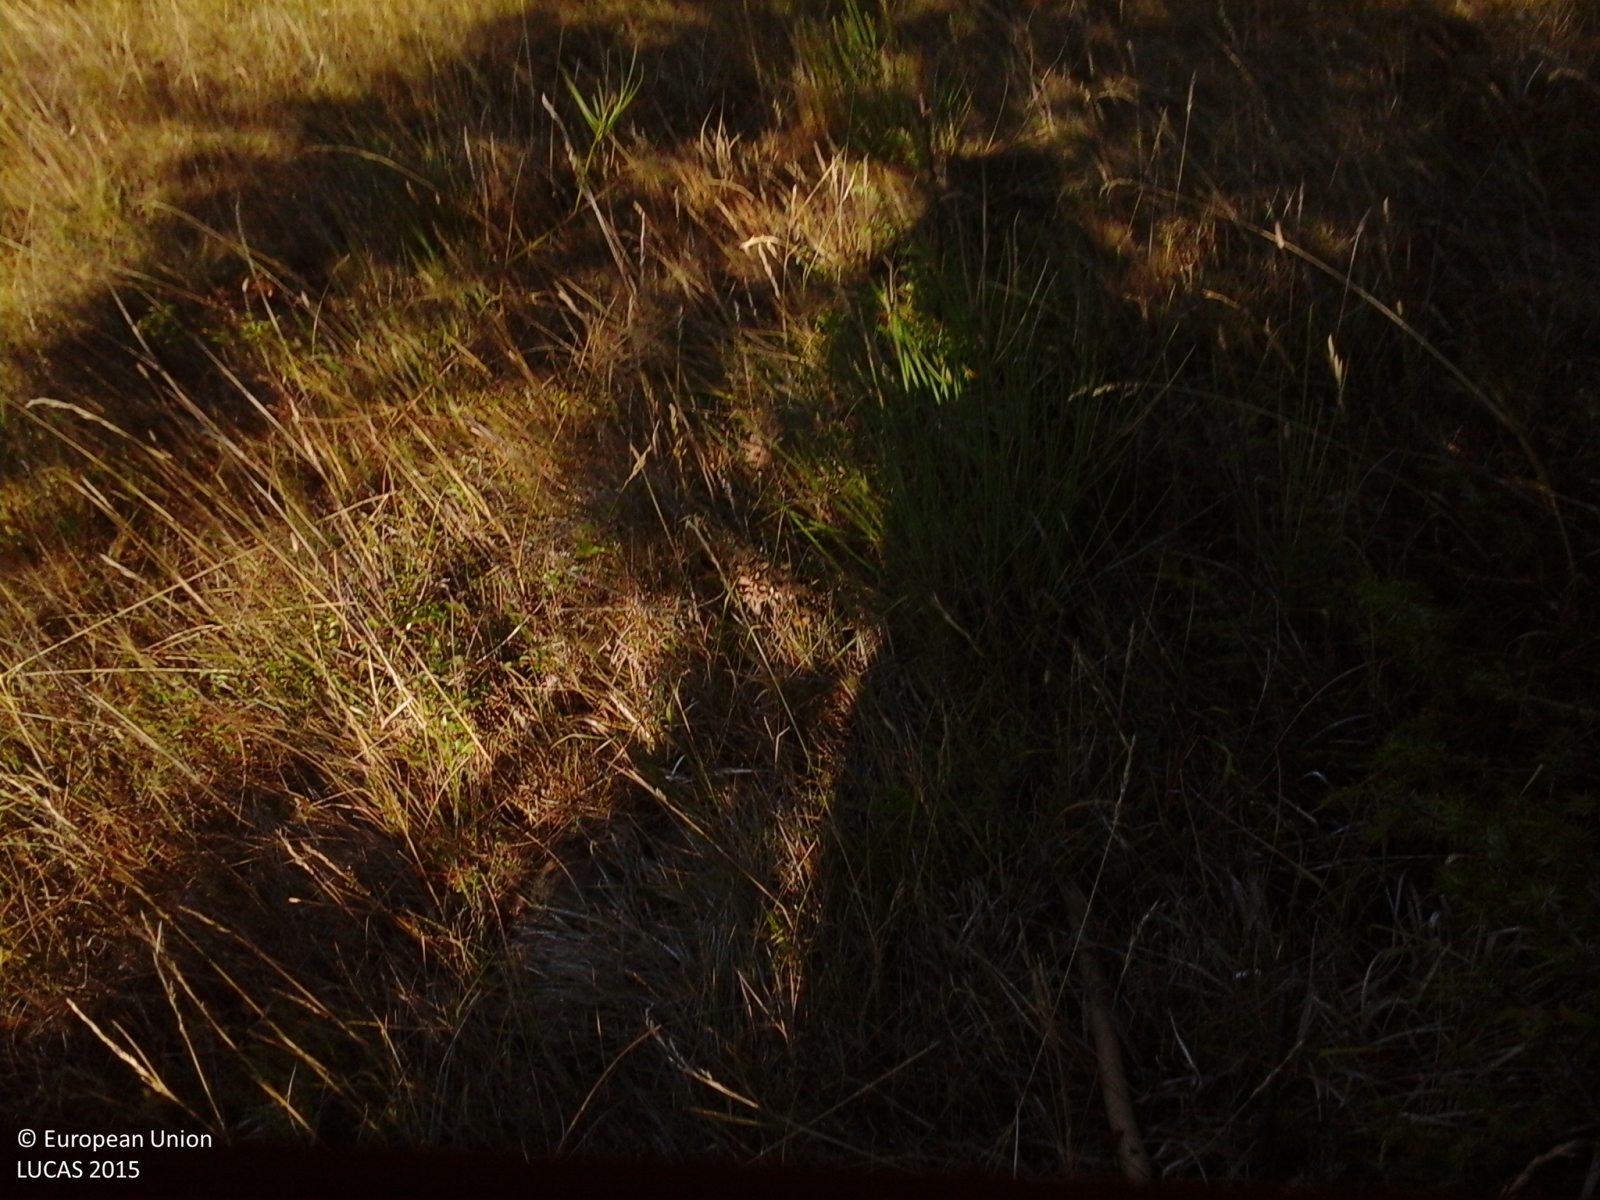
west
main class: Woodland
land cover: Broadleaved woodland
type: thermophilous deciduous forest
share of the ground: > 75 %
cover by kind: broadleaved forest trees 70 %, shrubs 20 %, herbaceous plants 10 %
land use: Semi-natural and natural areas not in use
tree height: < 5 m
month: August
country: IT
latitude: 42.9480
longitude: 11.6250
